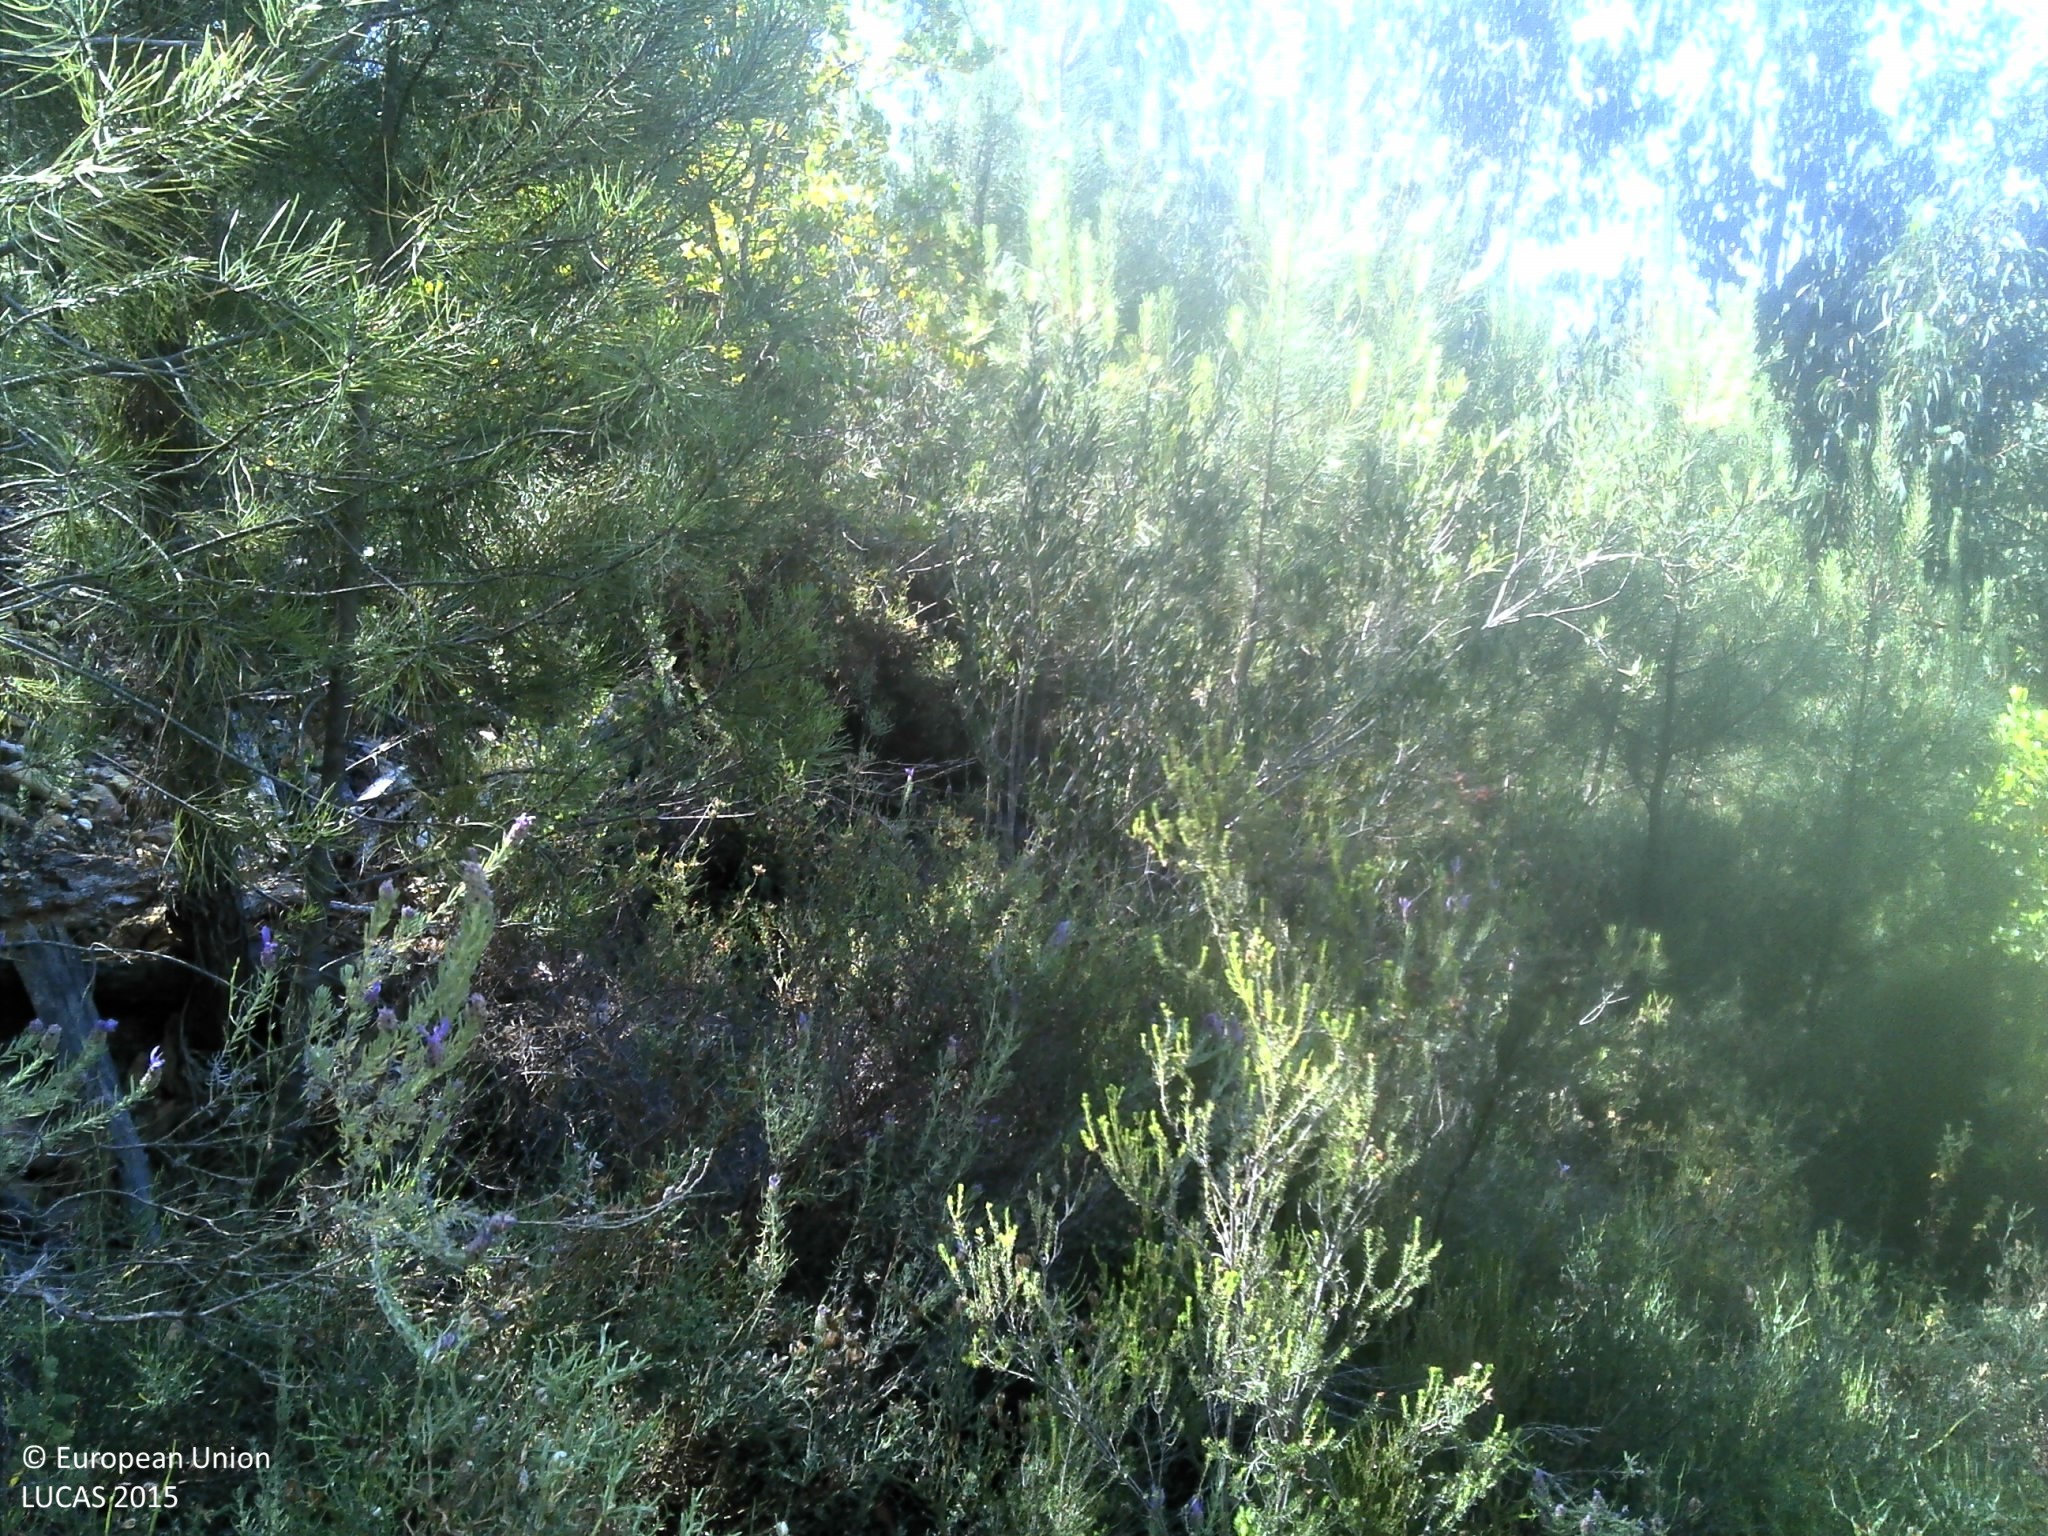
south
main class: Woodland
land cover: Pine dominated mixed woodland
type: coniferous forest of the mediterranean region
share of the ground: 25 - 50 %
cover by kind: coniferous forest trees 50 %, broadleaved forest trees 20 %, shrubs 15 %, unconsolidated bare surface 10 %, herbaceous plants 5 %
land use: Forestry
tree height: > 5 m
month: May
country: PT
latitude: 39.3449
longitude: -8.3880
